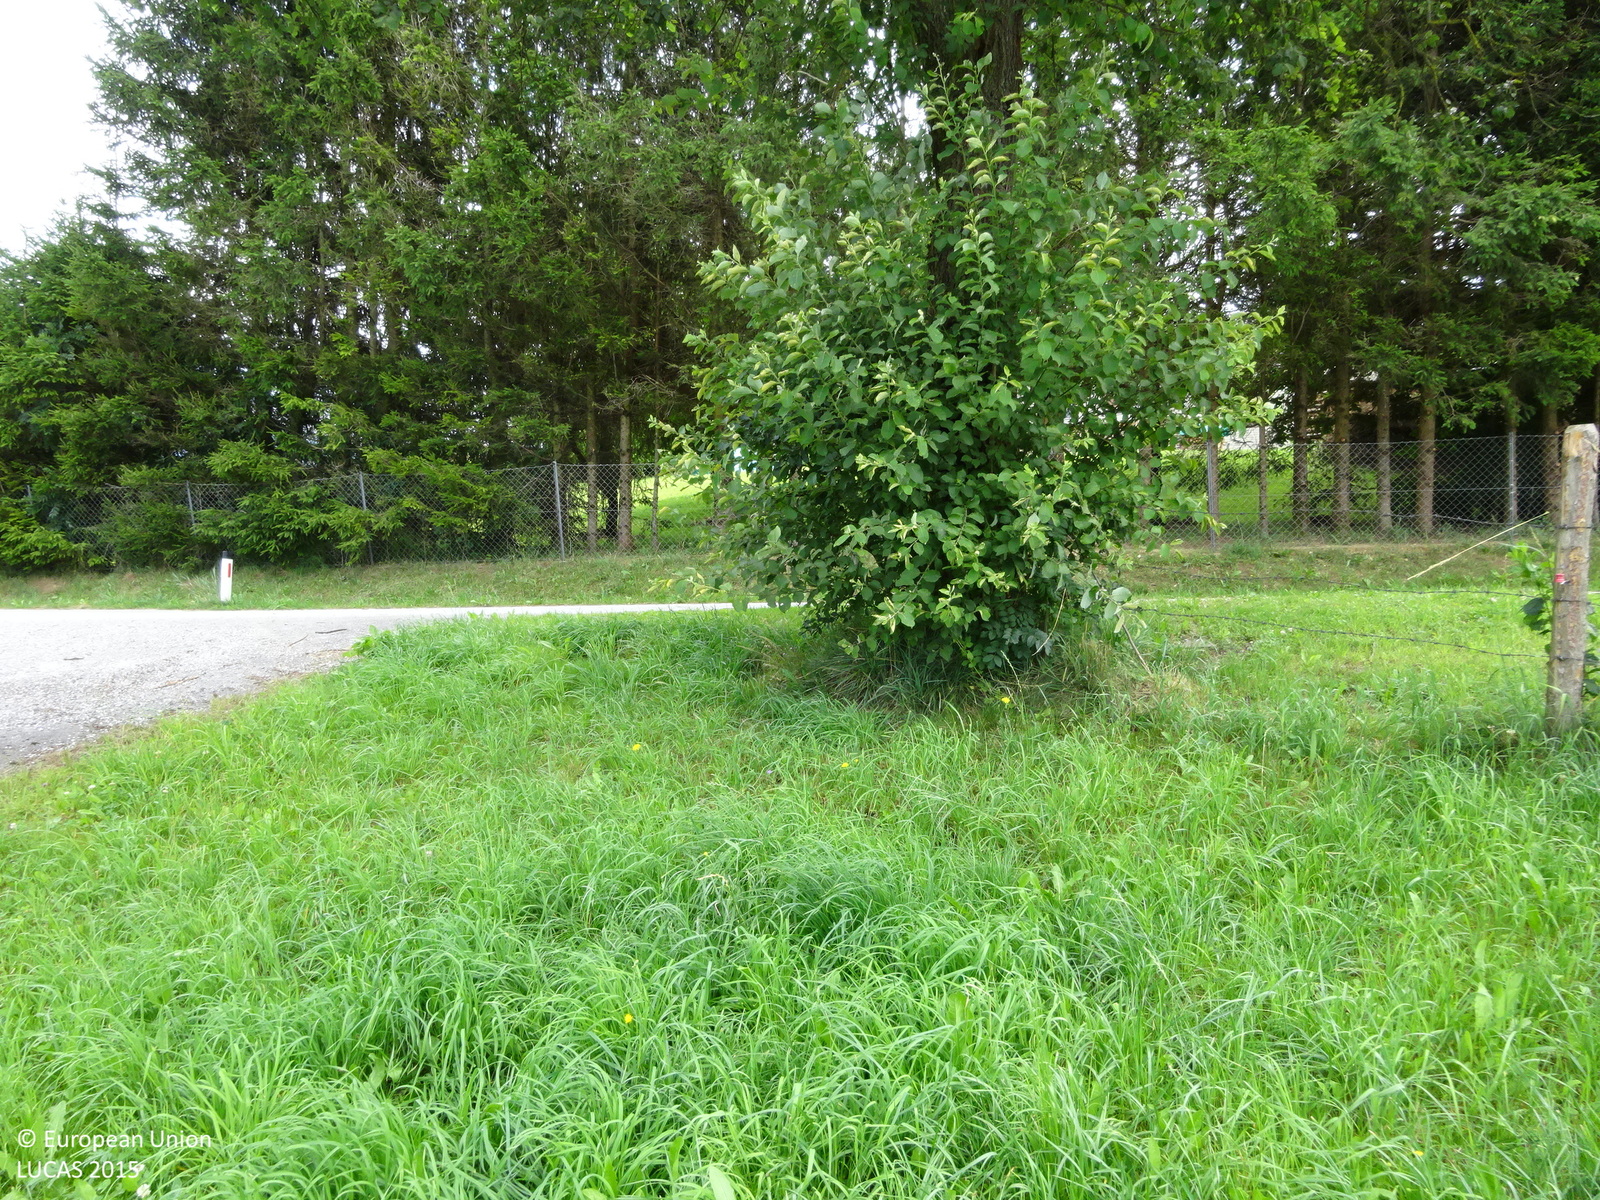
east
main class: Grassland
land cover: Grassland without tree/shrub cover
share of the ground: > 75 %
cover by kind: herbaceous plants 100 %
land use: Agriculture (excluding fallow land and kitchen gardens)
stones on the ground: < 10 %
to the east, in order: Grassland without tree/shrub cover; Single bushes/trees; Paved roads, cycling and walking lanes; Ditches and canals; Grass margins; Fences; Spruce dominated coniferous woodland; Grassland with sparse tree/shrub cover; Grass margins; Fences; Tracks; Lines of trees; Grassland without tree/shrub cover; Fences; Grassland without tree/shrub cover; Electric lines; Grassland without tree/shrub cover; Artificial constructions in urban areas; Grassland without tree/shrub cover
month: July
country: AT
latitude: 47.2739
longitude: 15.5127
